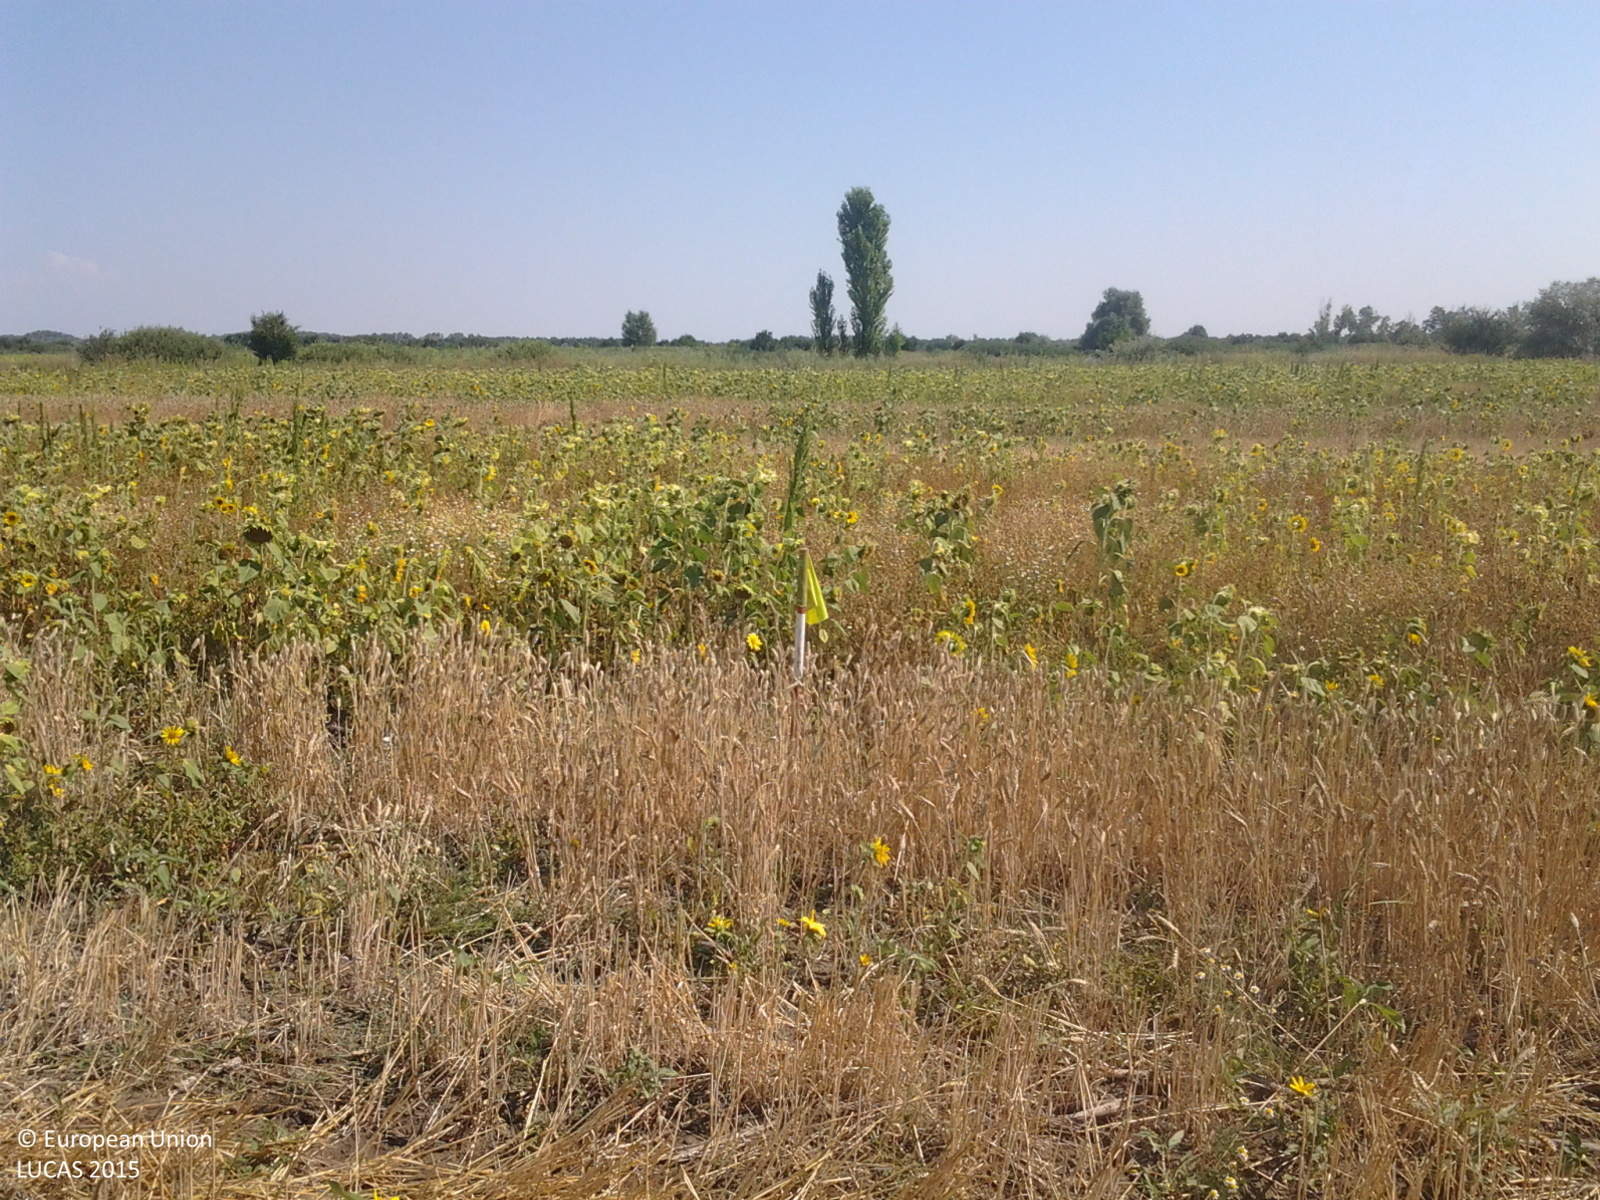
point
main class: Cropland
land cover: Common wheat
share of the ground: 50 - 75 %
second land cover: Sunflower
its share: 25 - 50 %
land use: Agriculture (excluding fallow land and kitchen gardens)
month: July
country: HU
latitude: 47.3320
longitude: 20.5780
